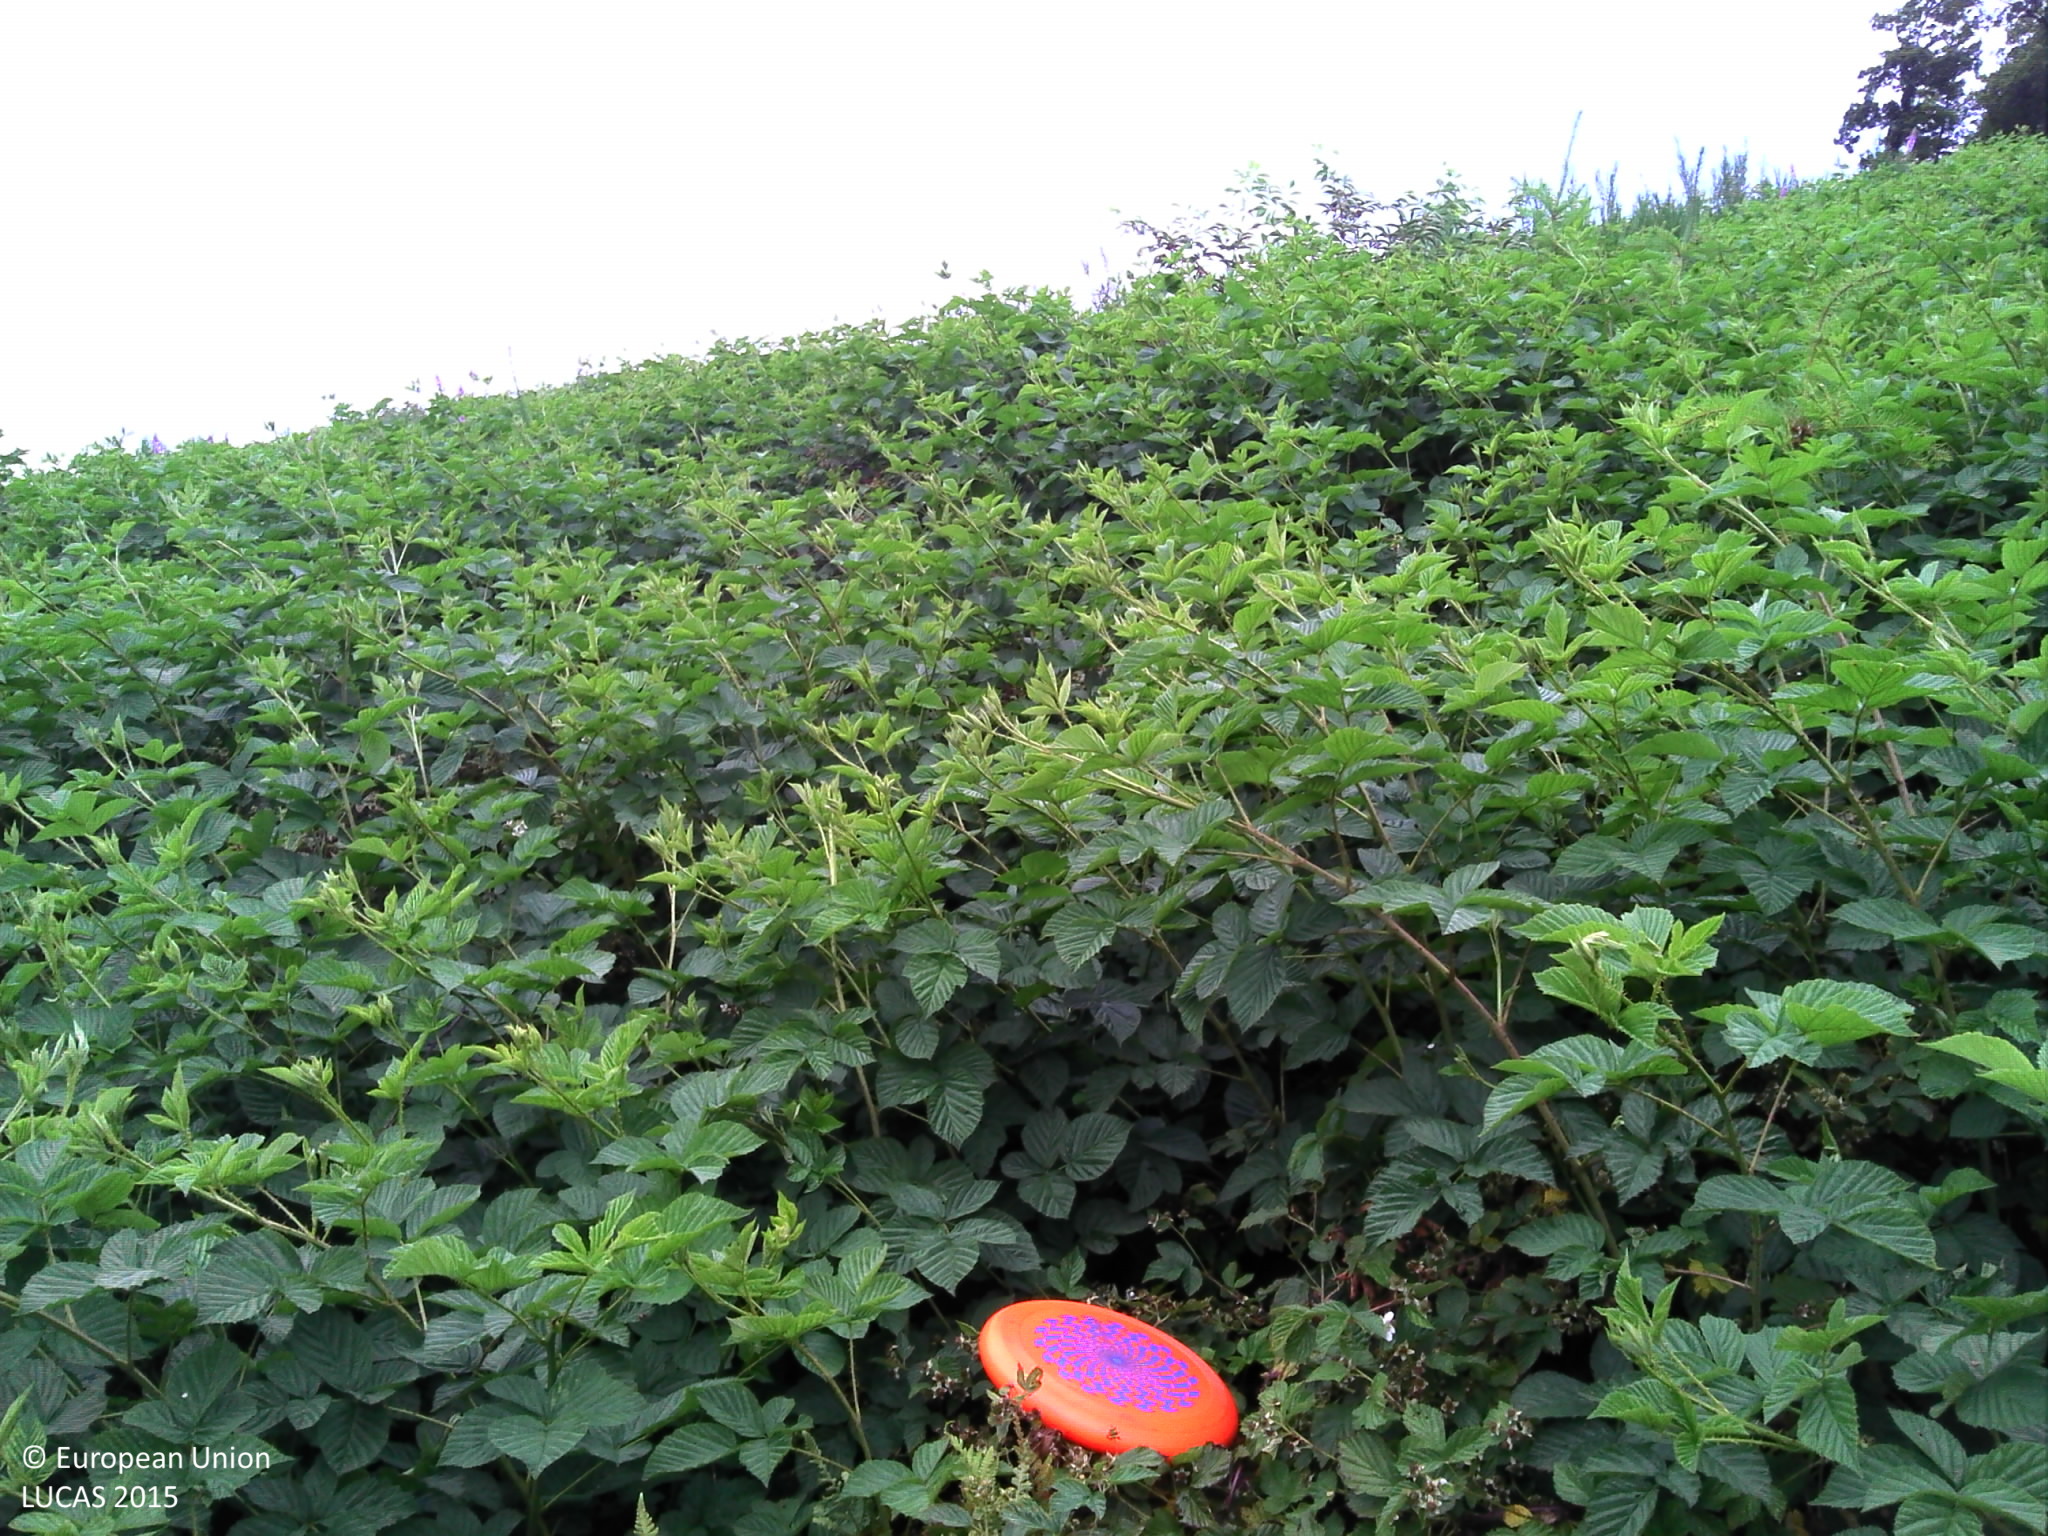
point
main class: Shrubland
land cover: Shrubland without tree cover
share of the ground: > 75 %
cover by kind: herbaceous plants 65 %, shrubs 35 %
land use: Forestry
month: July
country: BE
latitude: 50.2722
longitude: 5.8879
